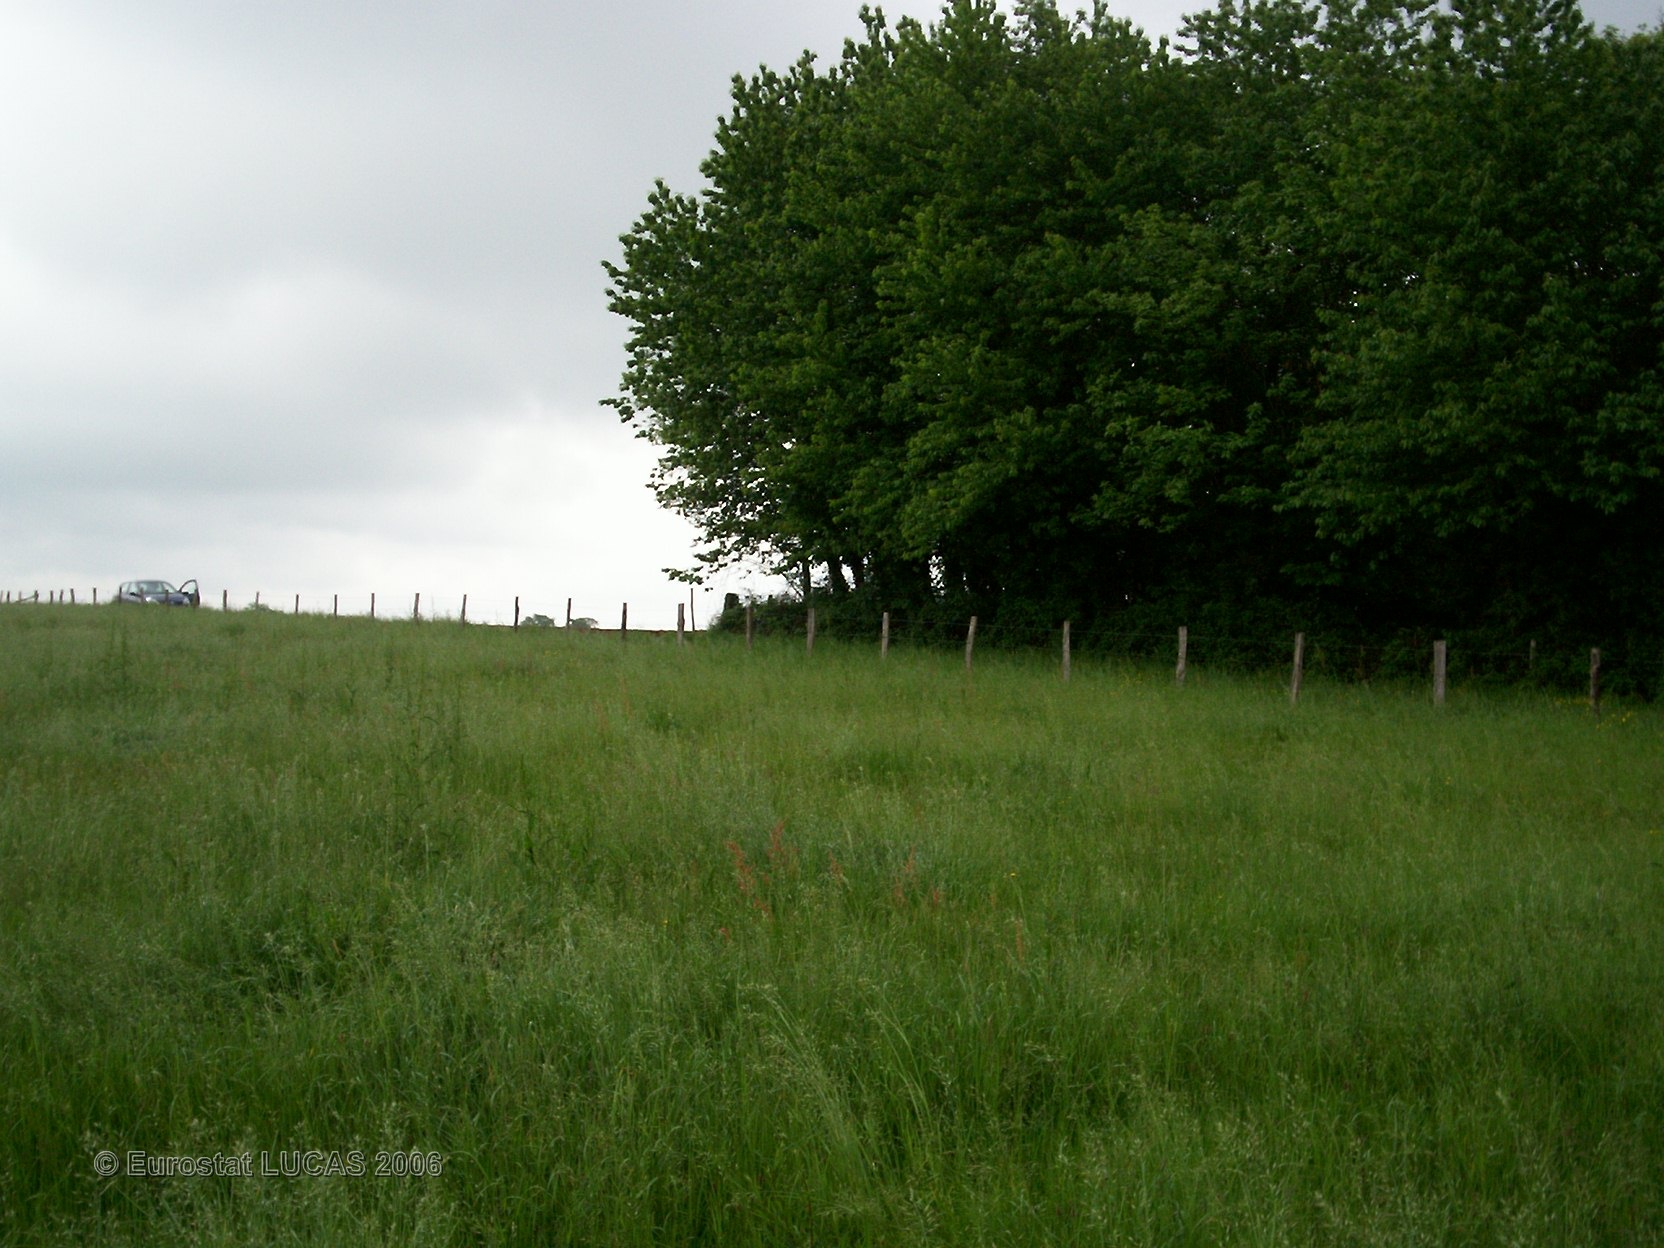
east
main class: Grassland
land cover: Grassland without tree/shrub cover
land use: Agriculture (excluding fallow land and kitchen gardens)
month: May
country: FR
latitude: 45.7807
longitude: 0.4808
